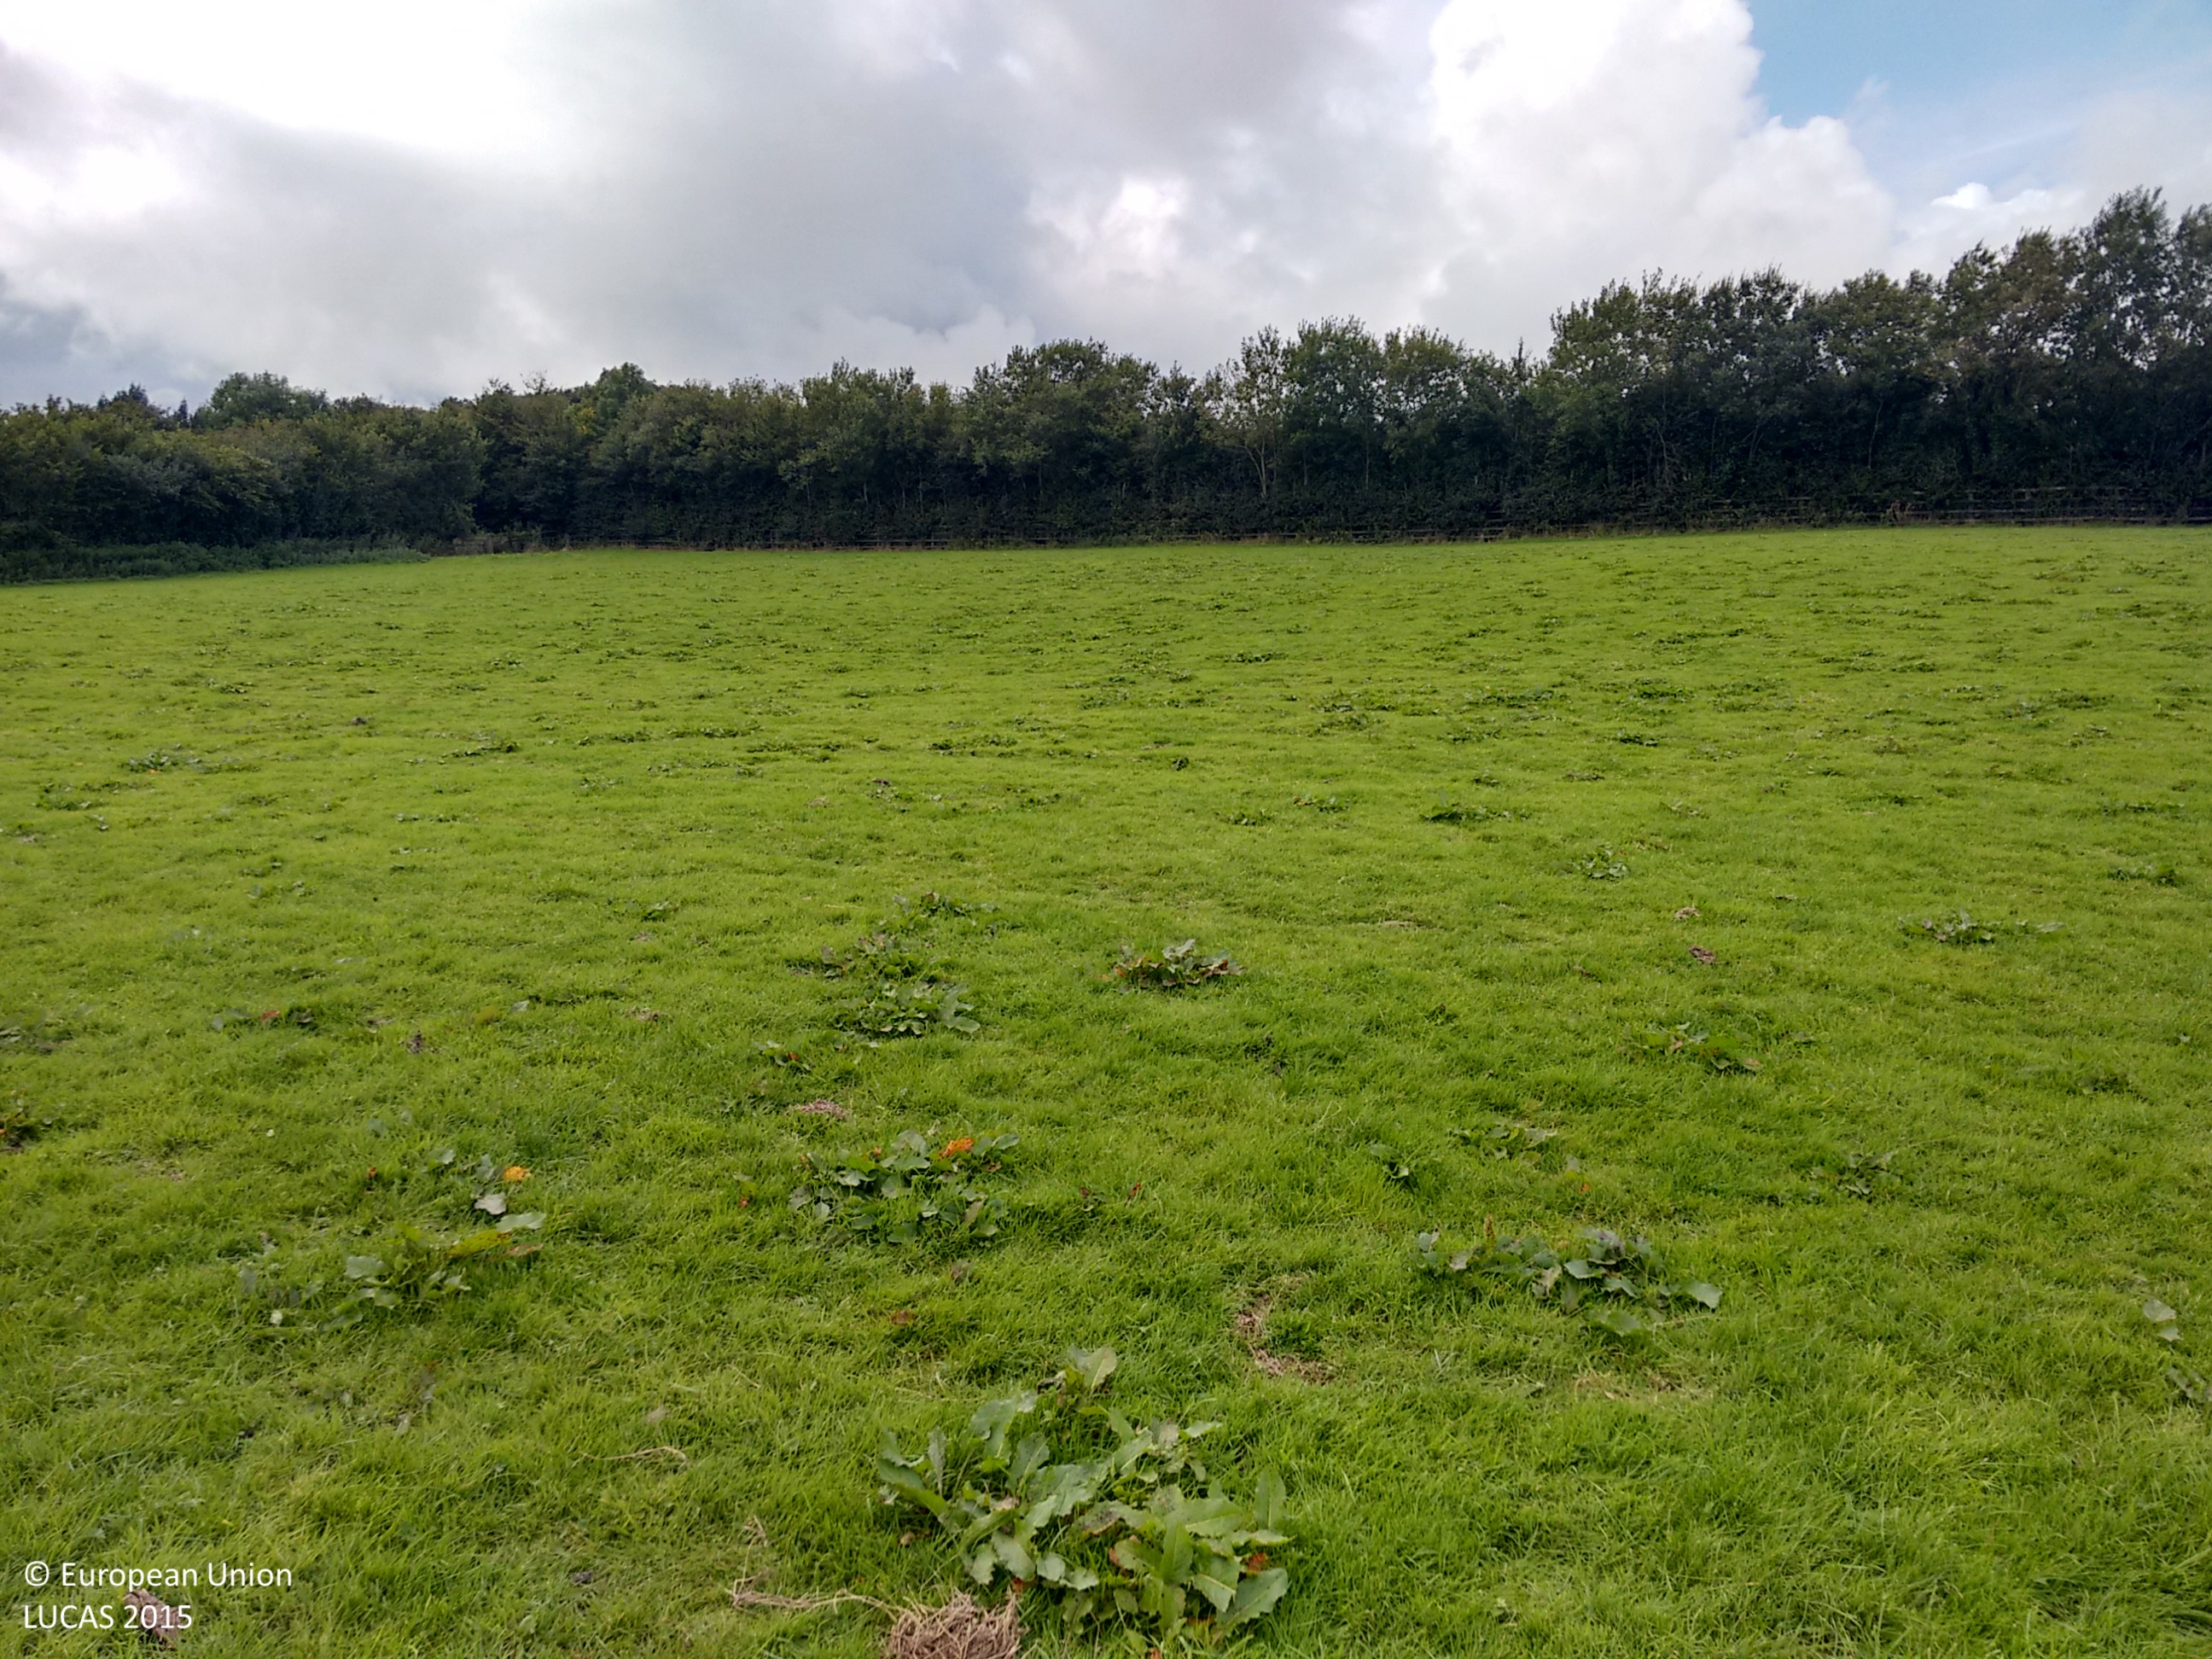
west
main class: Grassland
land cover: Grassland without tree/shrub cover
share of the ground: > 75 %
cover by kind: herbaceous plants 100 %
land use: Agriculture (excluding fallow land and kitchen gardens)
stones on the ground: < 10 %
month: September
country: GB
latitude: 50.7151
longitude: -4.0454
